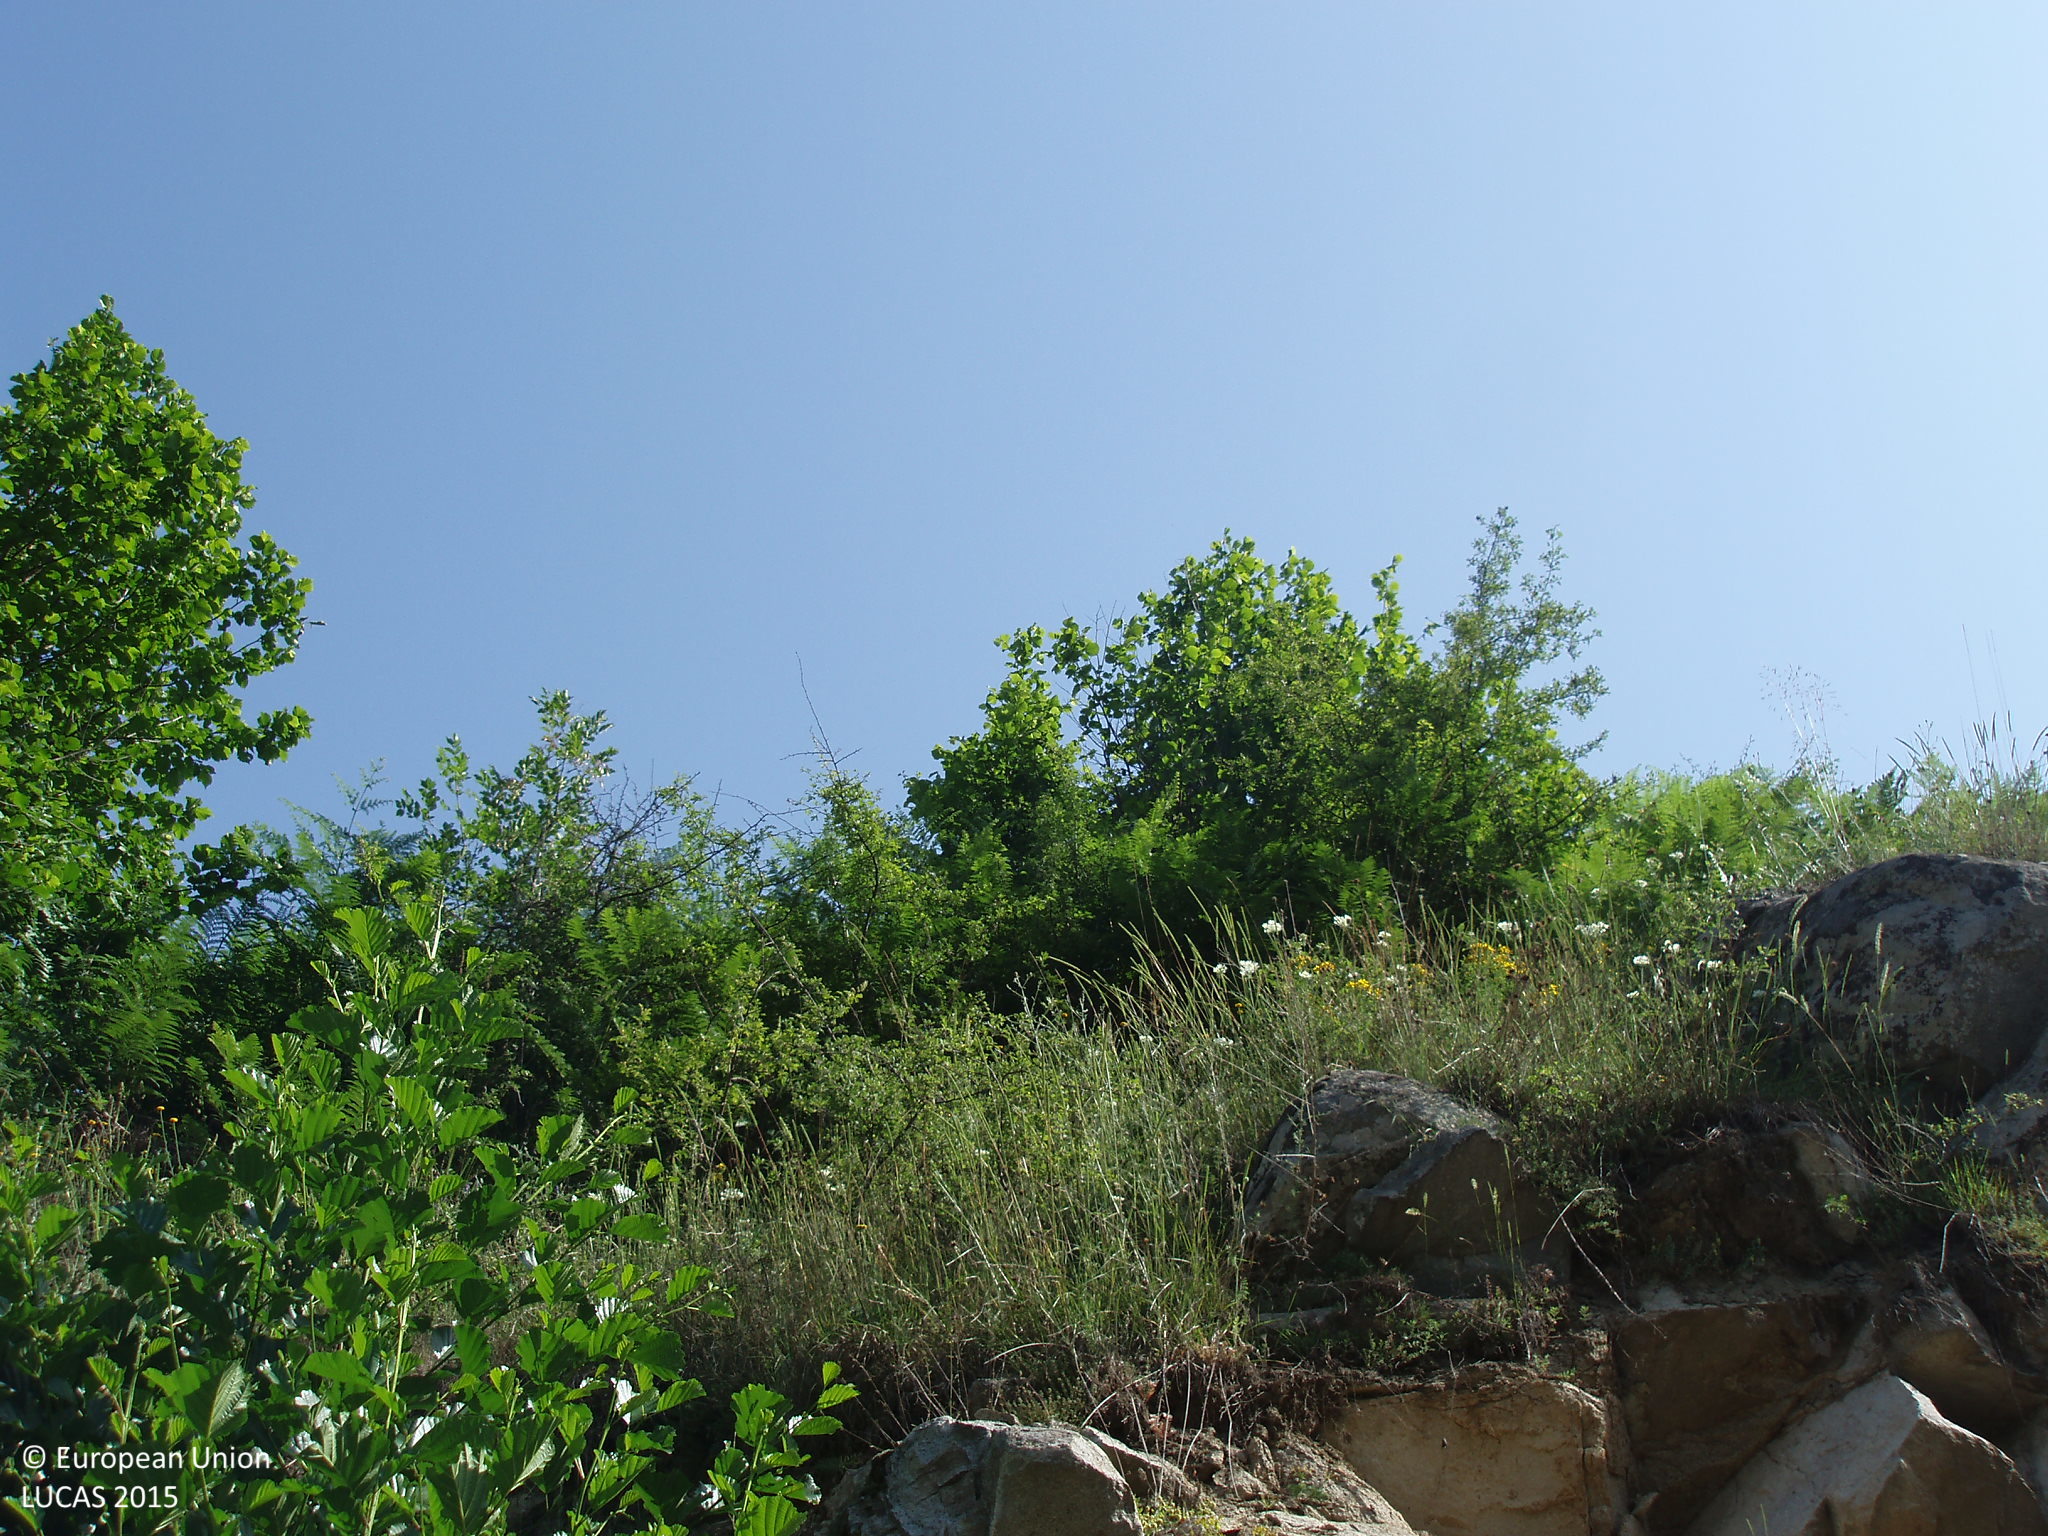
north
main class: Woodland
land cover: Pine dominated mixed woodland
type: hemiboreal forest and nemoral coniferous forest and mixed broadleaved-coniferous forest
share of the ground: > 75 %
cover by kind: coniferous forest trees 75 %, broadleaved forest trees 25 %
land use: Forestry
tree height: > 5 m
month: June
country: BG
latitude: 41.4605
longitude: 23.7109
